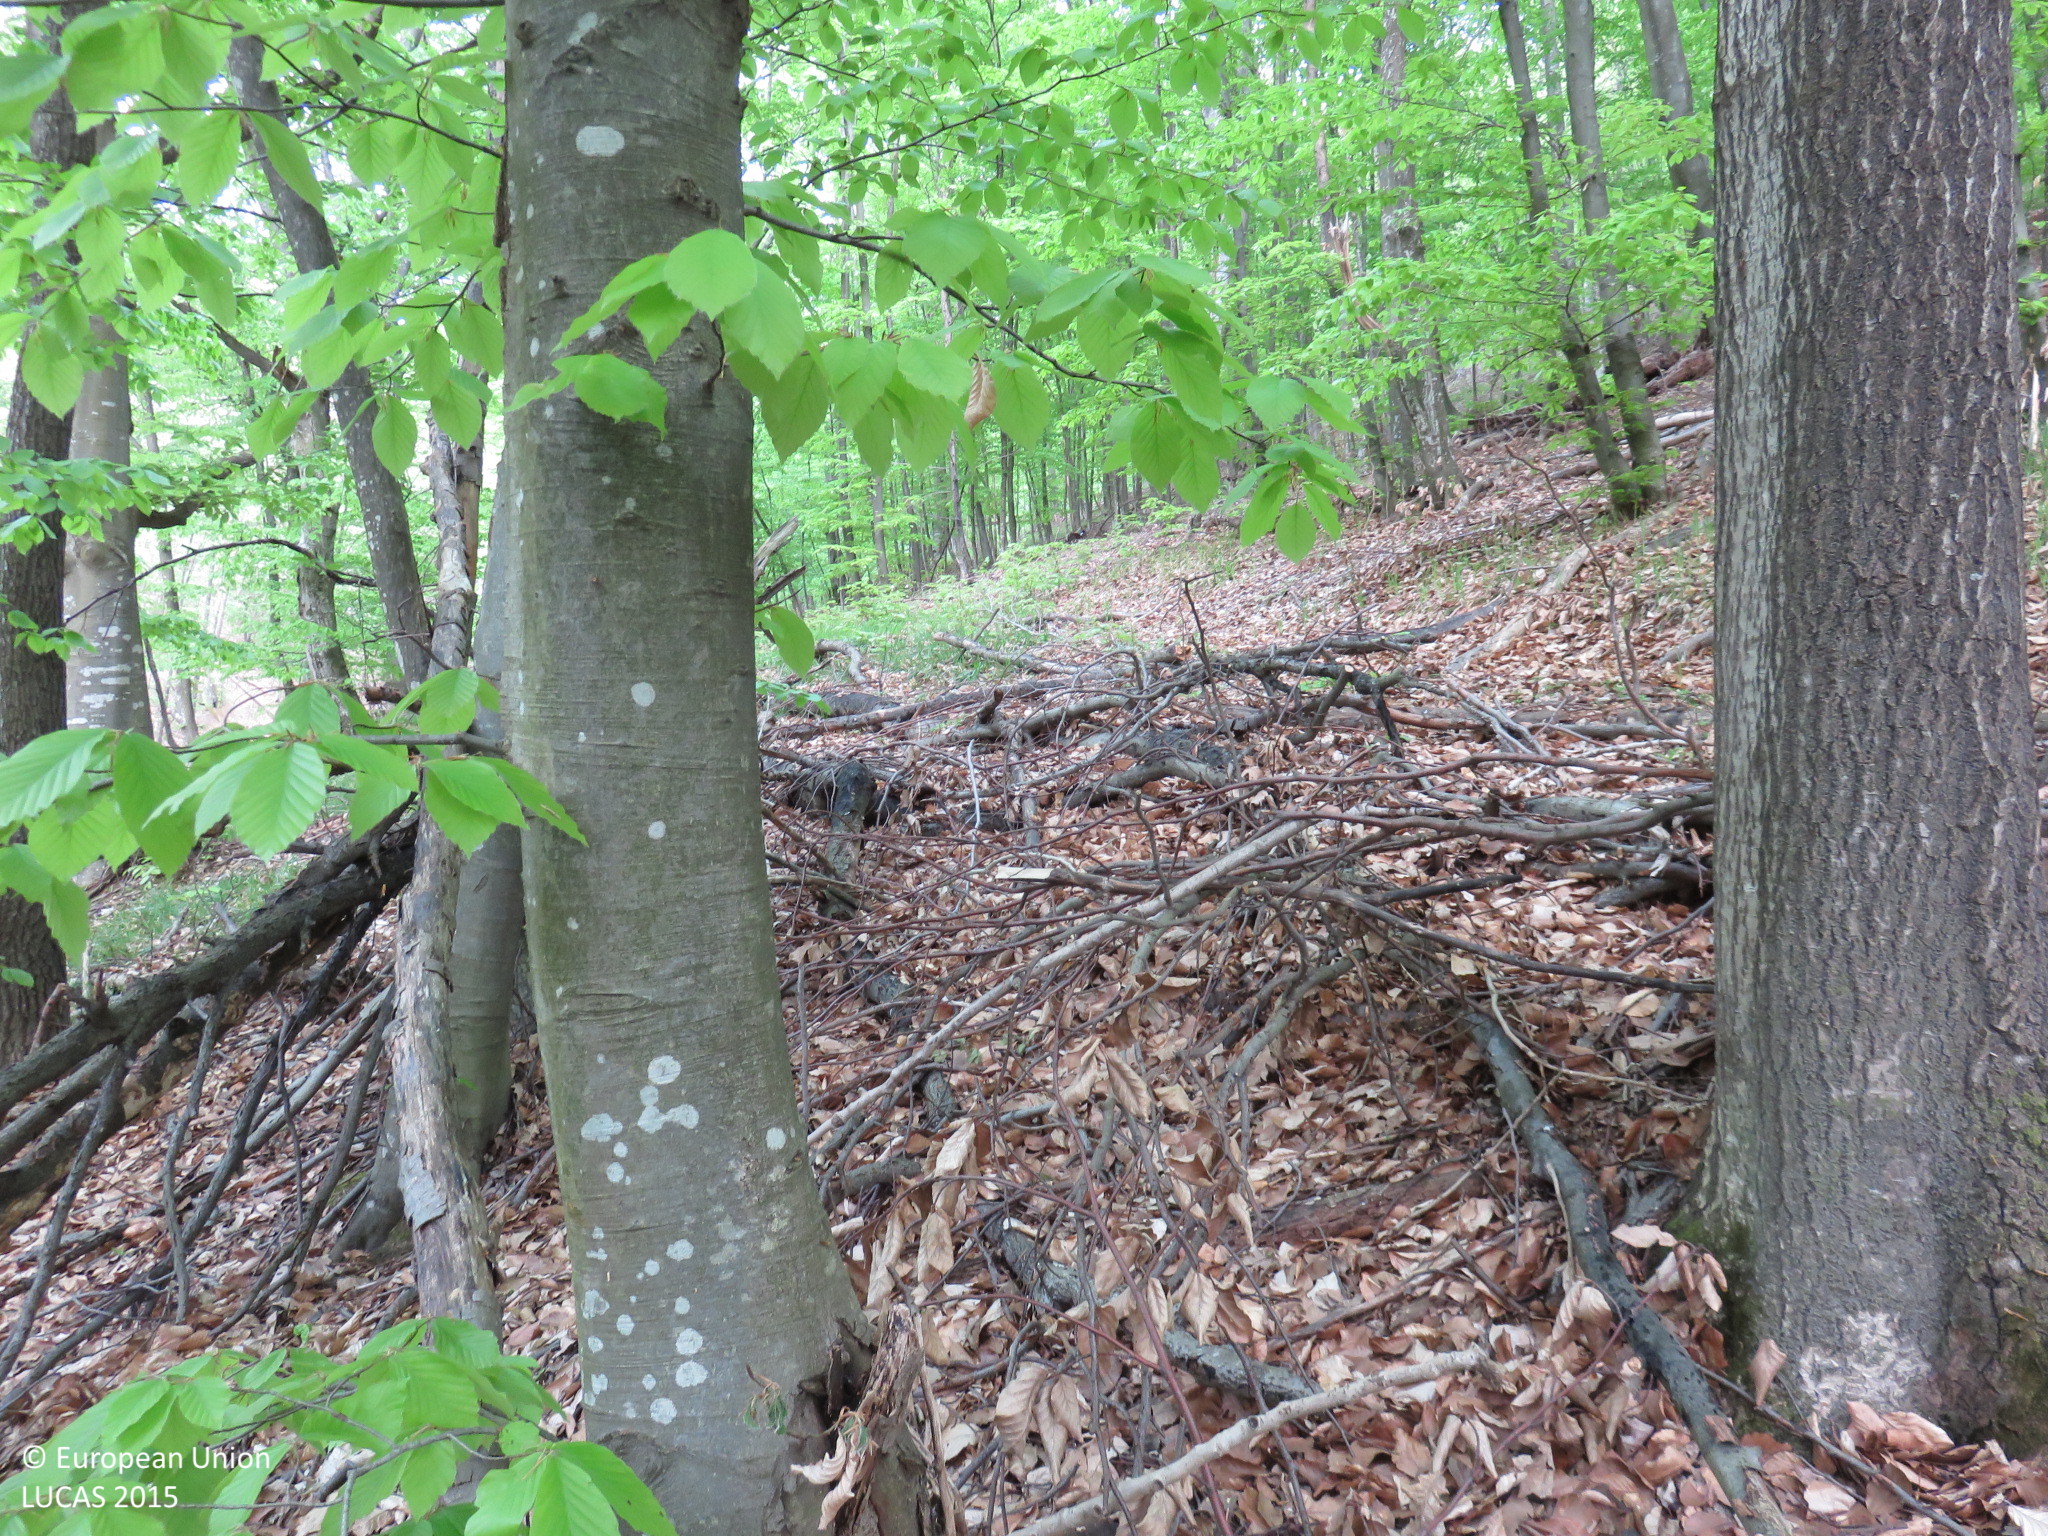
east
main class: Woodland
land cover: Broadleaved woodland
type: beech forest
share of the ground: > 75 %
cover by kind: broadleaved forest trees 80 %, unconsolidated bare surface 20 %
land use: Forestry
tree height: > 5 m
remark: Clear cut
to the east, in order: Broadleaved woodland; Tracks; Broadleaved woodland; Tracks; Broadleaved woodland; Rivers and streams
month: April
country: BG
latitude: 43.0187
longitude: 24.8490
